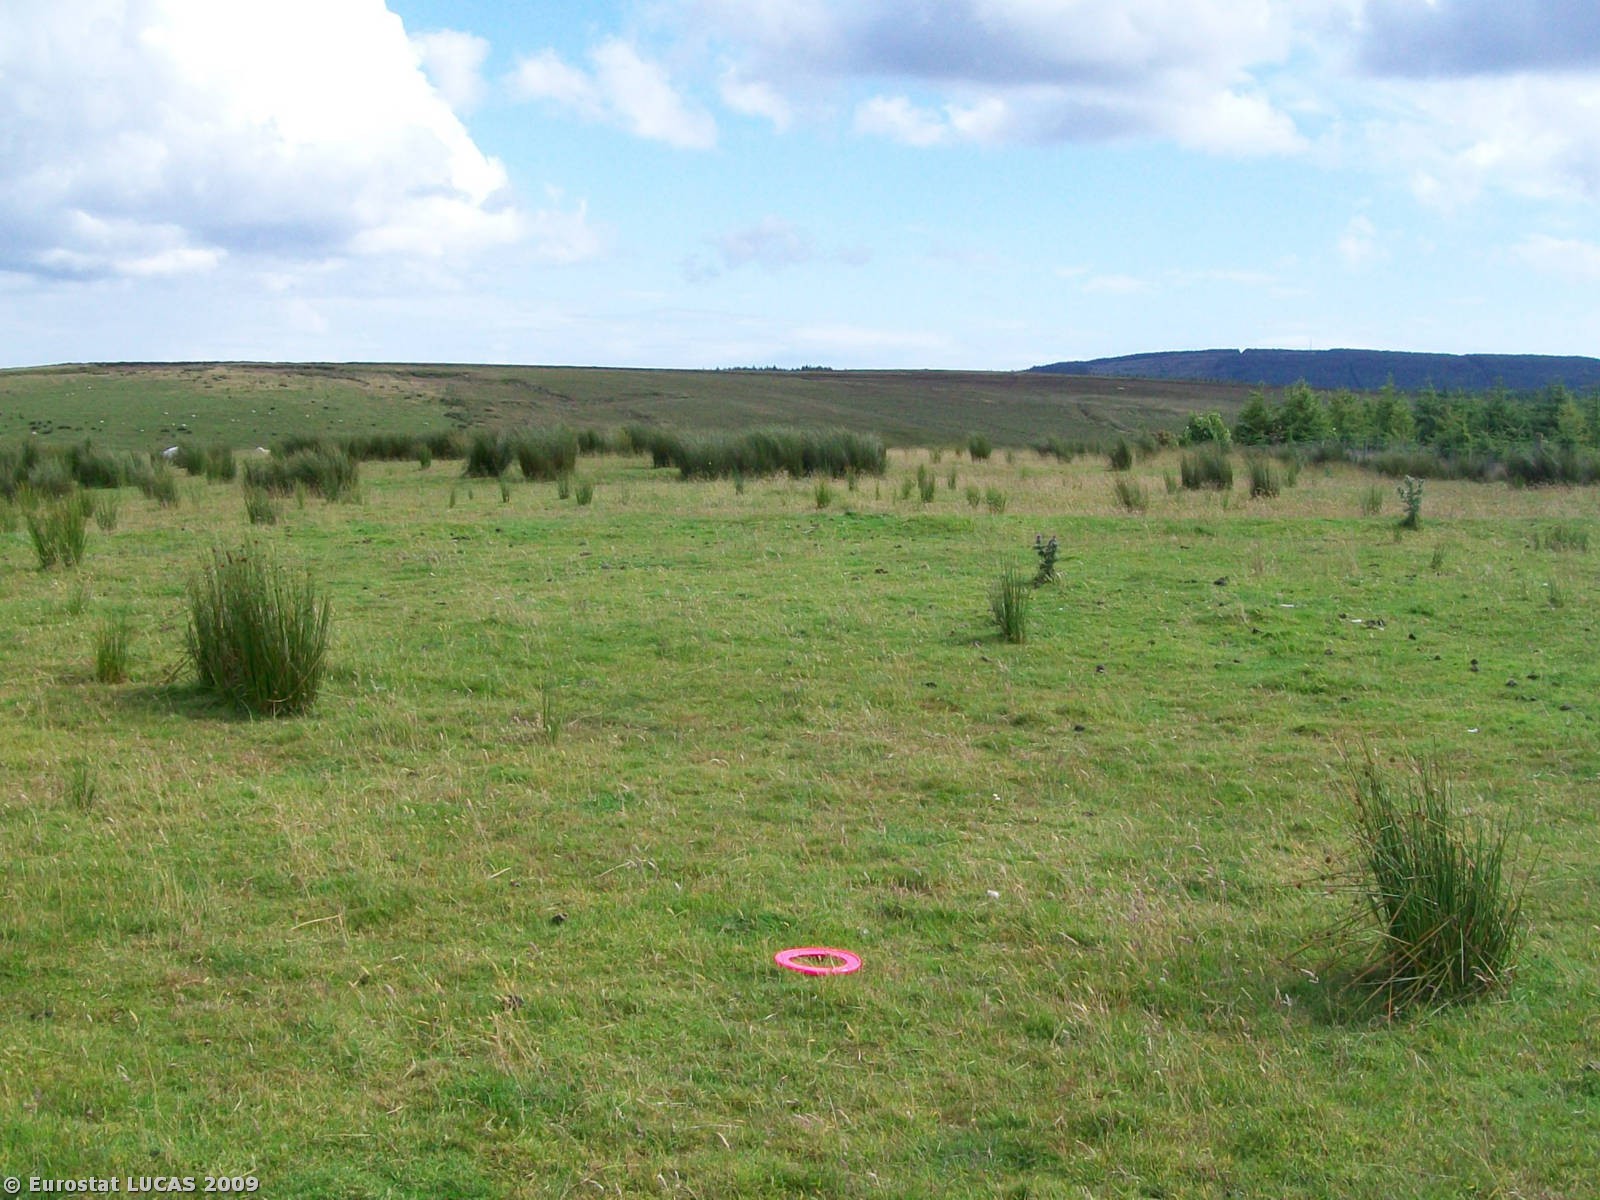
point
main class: Grassland
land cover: Grassland without tree/shrub cover
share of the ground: > 75 %
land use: Agriculture (excluding fallow land and kitchen gardens)
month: July
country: GB
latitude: 55.1484
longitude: -6.1965
